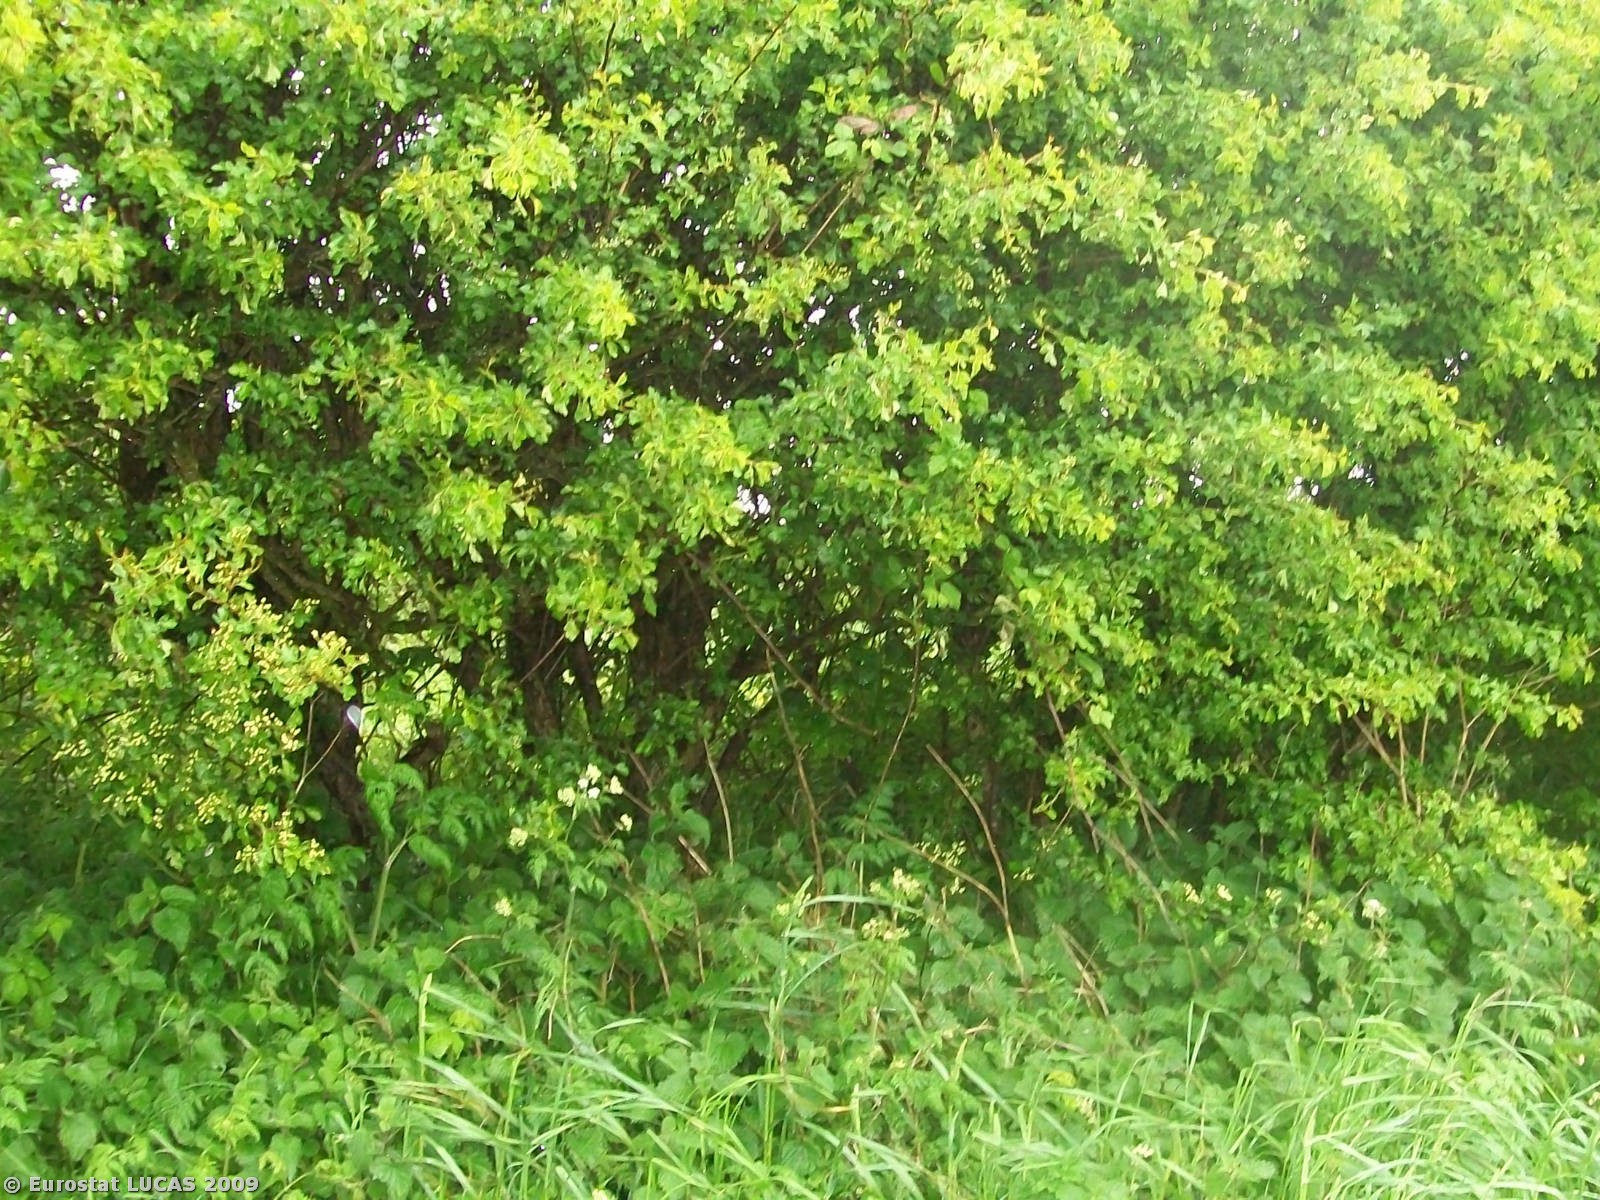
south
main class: Cropland
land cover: Common wheat
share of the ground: > 75 %
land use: Agriculture (excluding fallow land and kitchen gardens)
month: May
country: GB
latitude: 54.1268
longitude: -0.4566
